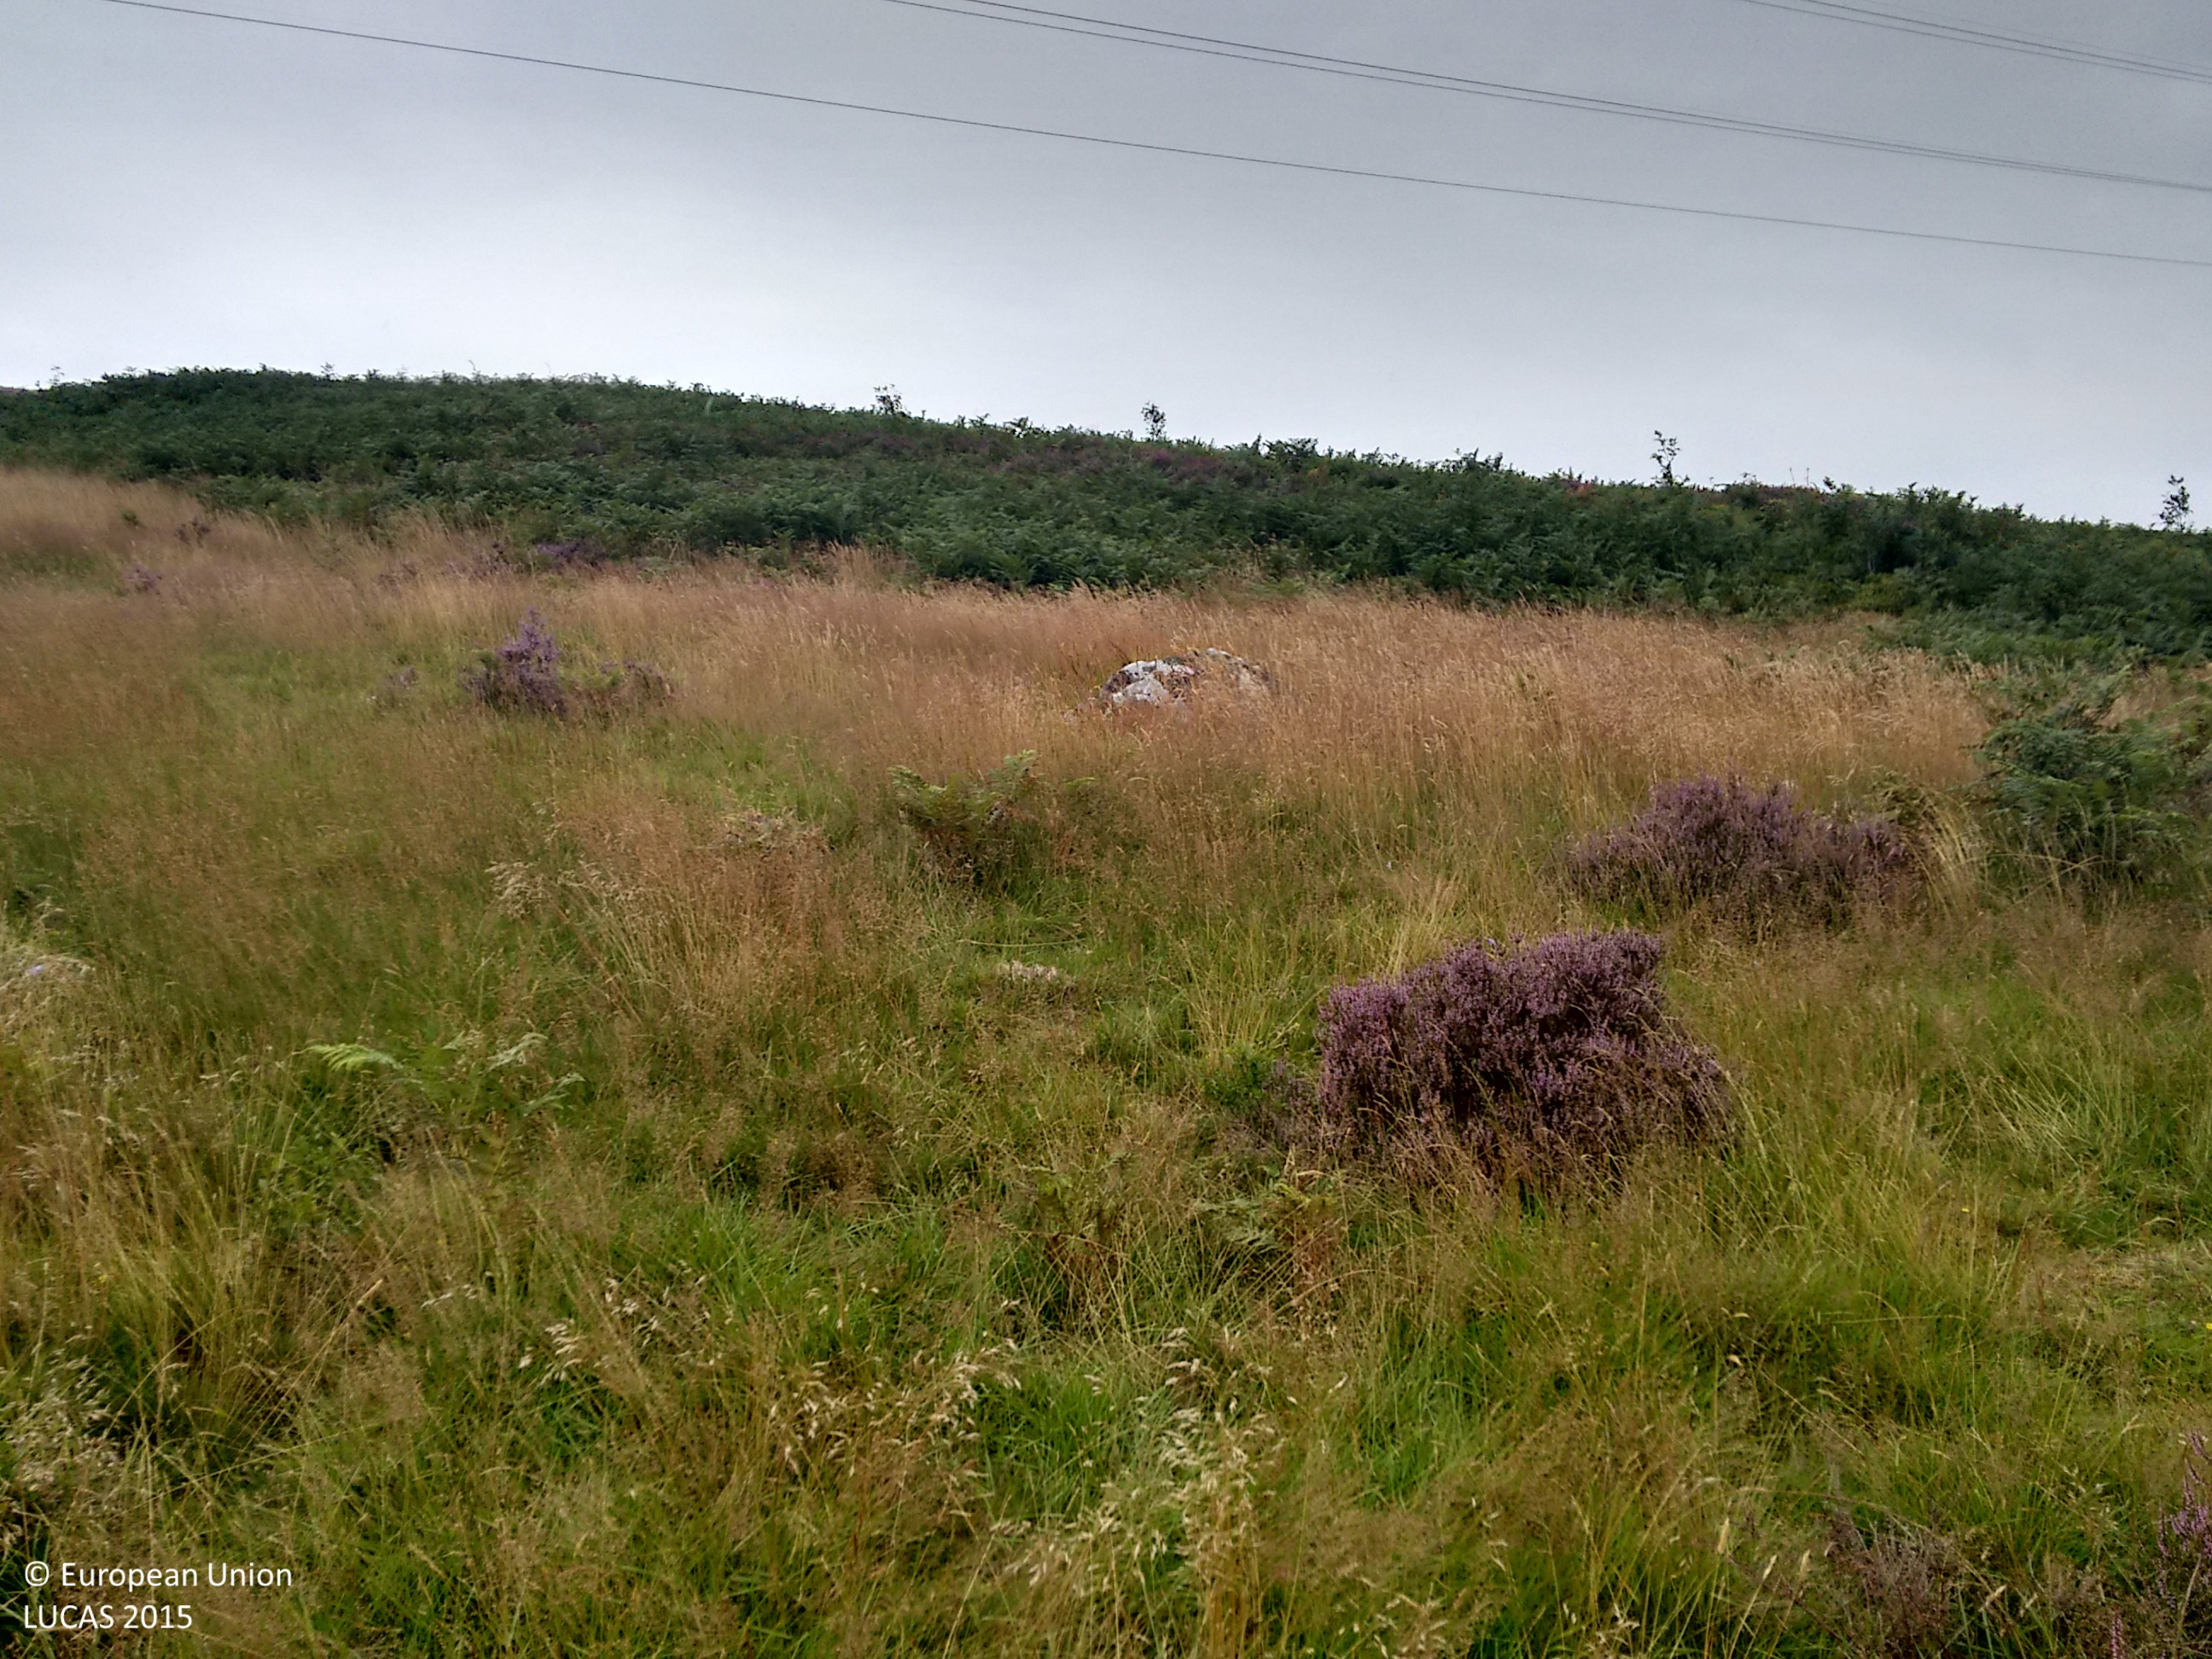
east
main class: Grassland
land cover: Grassland without tree/shrub cover
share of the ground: > 75 %
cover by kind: herbaceous plants 95 %, shrubs 5 %
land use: Semi-natural and natural areas not in use
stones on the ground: < 10 %
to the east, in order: Grassland without tree/shrub cover; Shrubland without tree cover; Rivers and streams; Shrubland without tree cover; Tracks; Electric lines; Shrubland without tree cover; Grassland without tree/shrub cover; Shrubland without tree cover; Grassland without tree/shrub cover; Single bushes/trees; Shrubland without tree cover; Grassland without tree/shrub cover
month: August
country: GB
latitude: 55.1417
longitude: -2.9820
